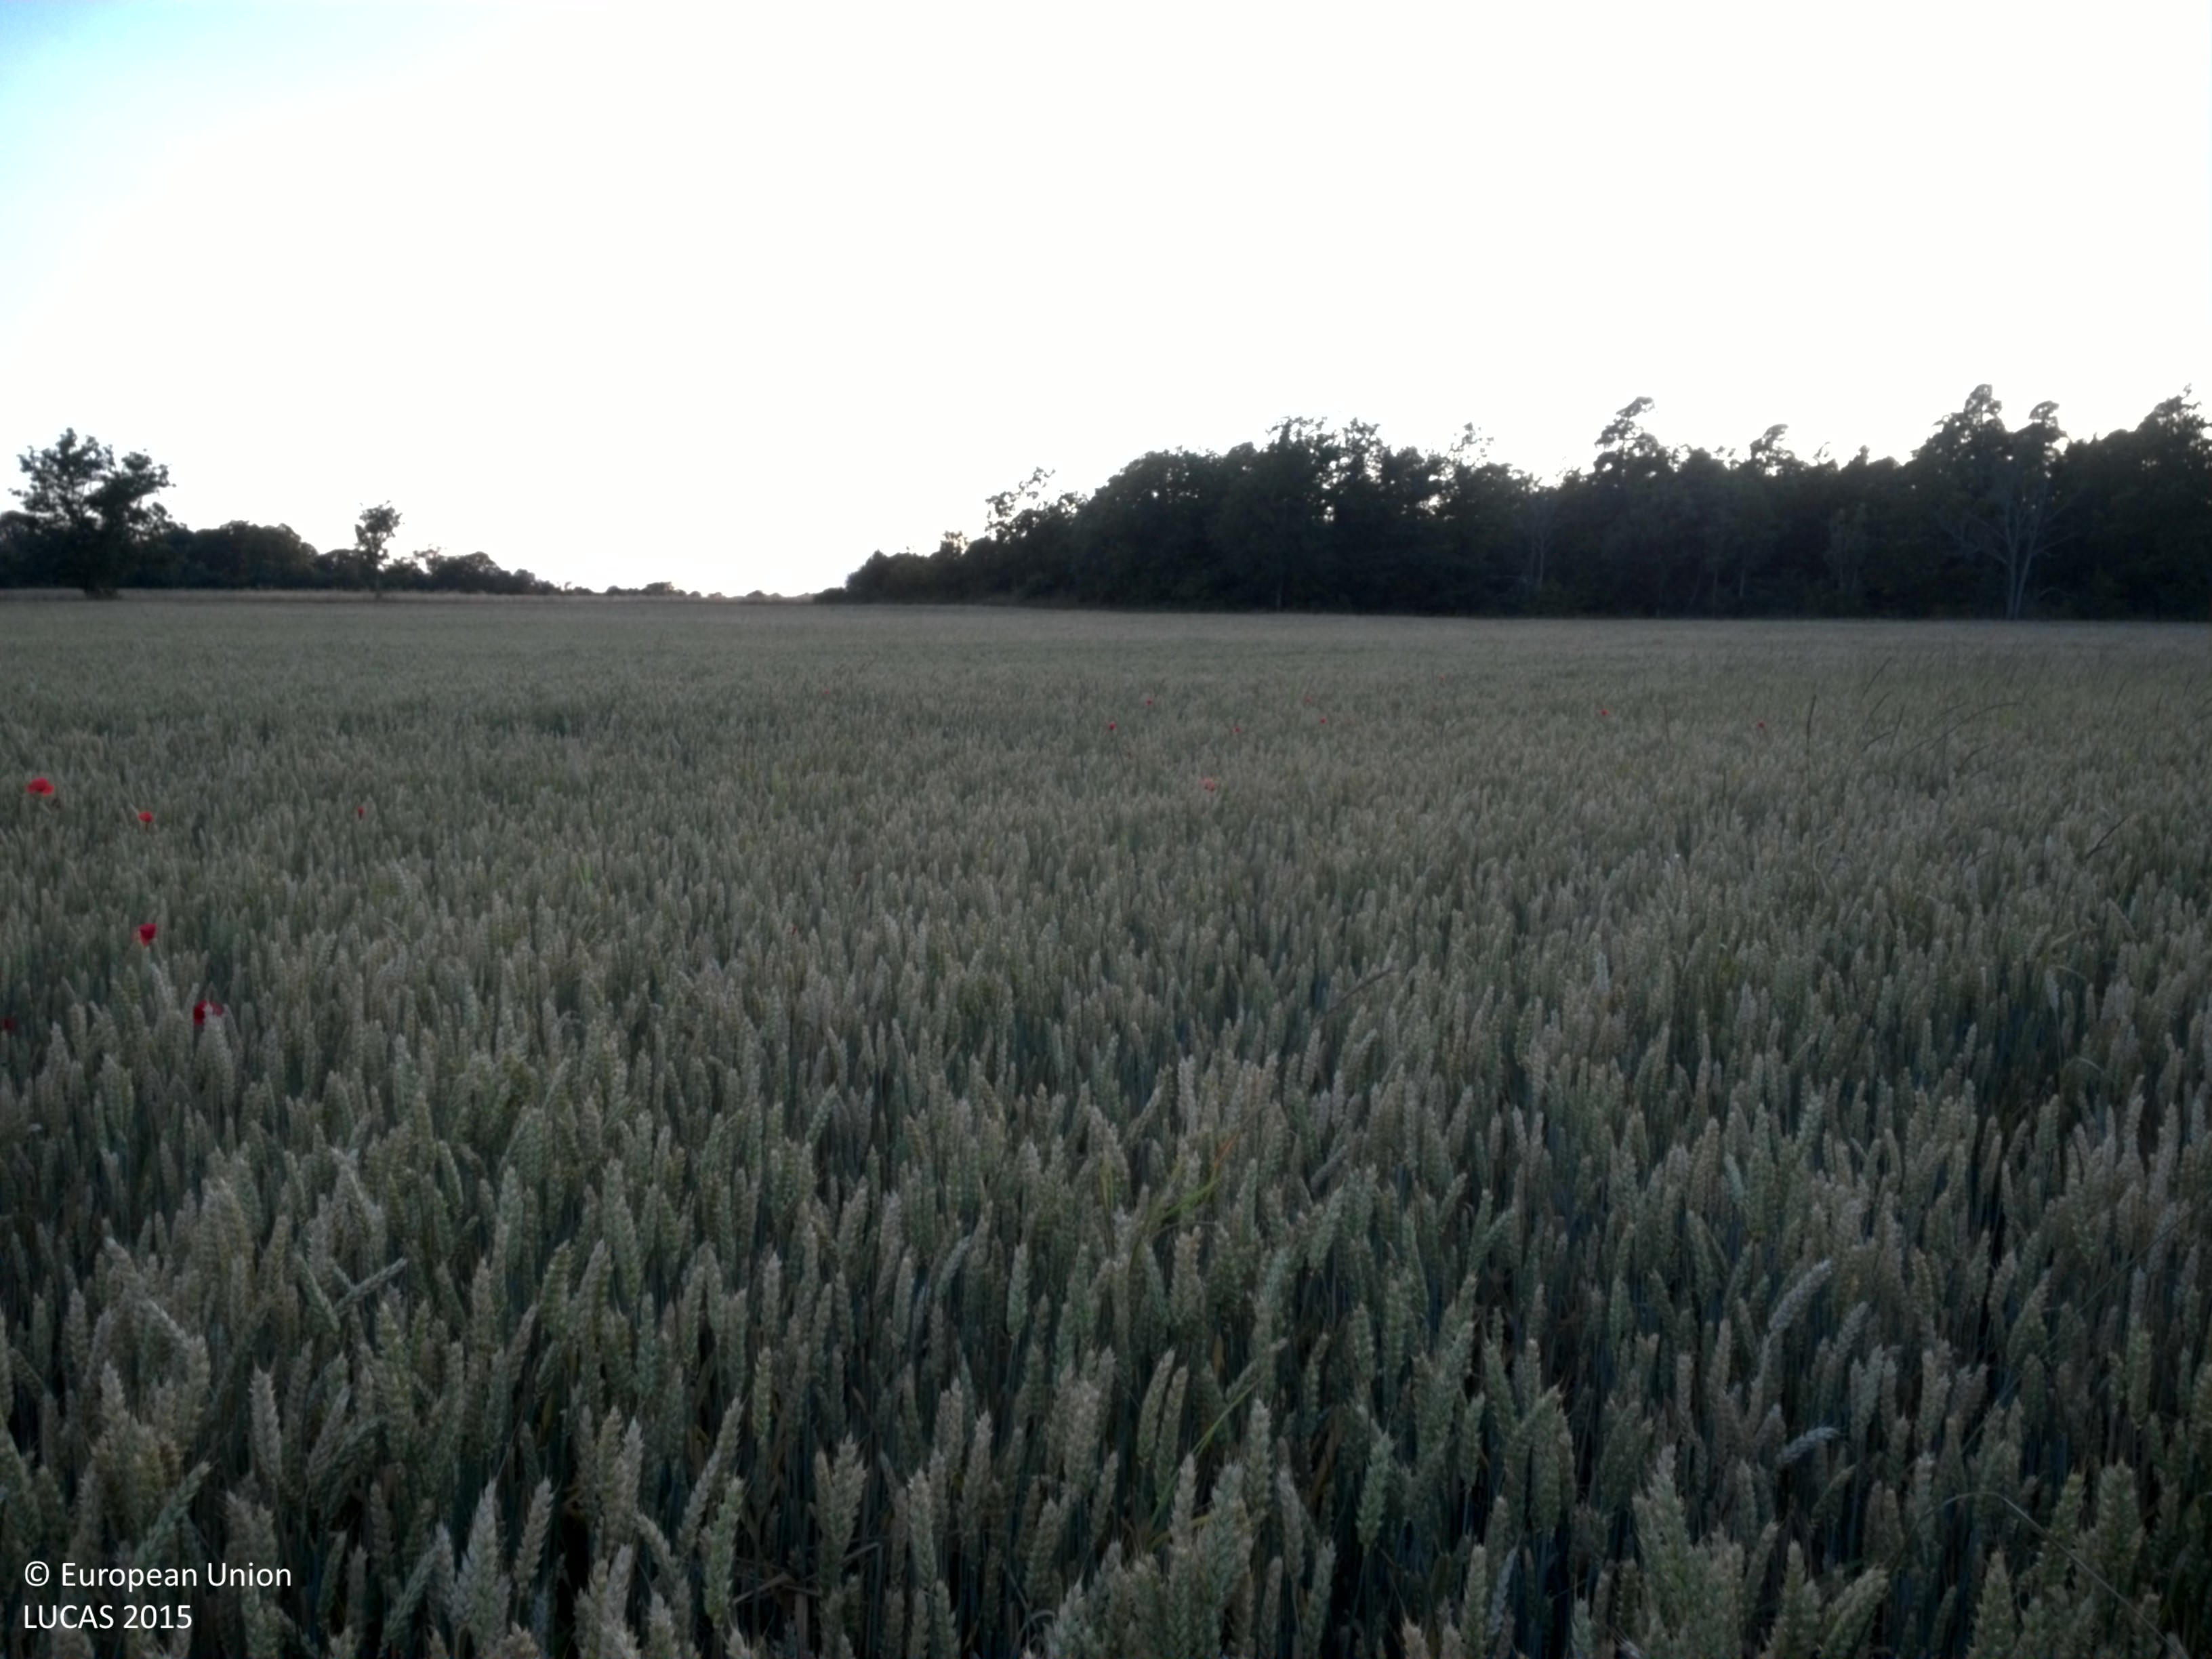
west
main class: Cropland
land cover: Common wheat
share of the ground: > 75 %
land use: Agriculture (excluding fallow land and kitchen gardens)
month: July
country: SE
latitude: 57.2835
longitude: 18.4529
